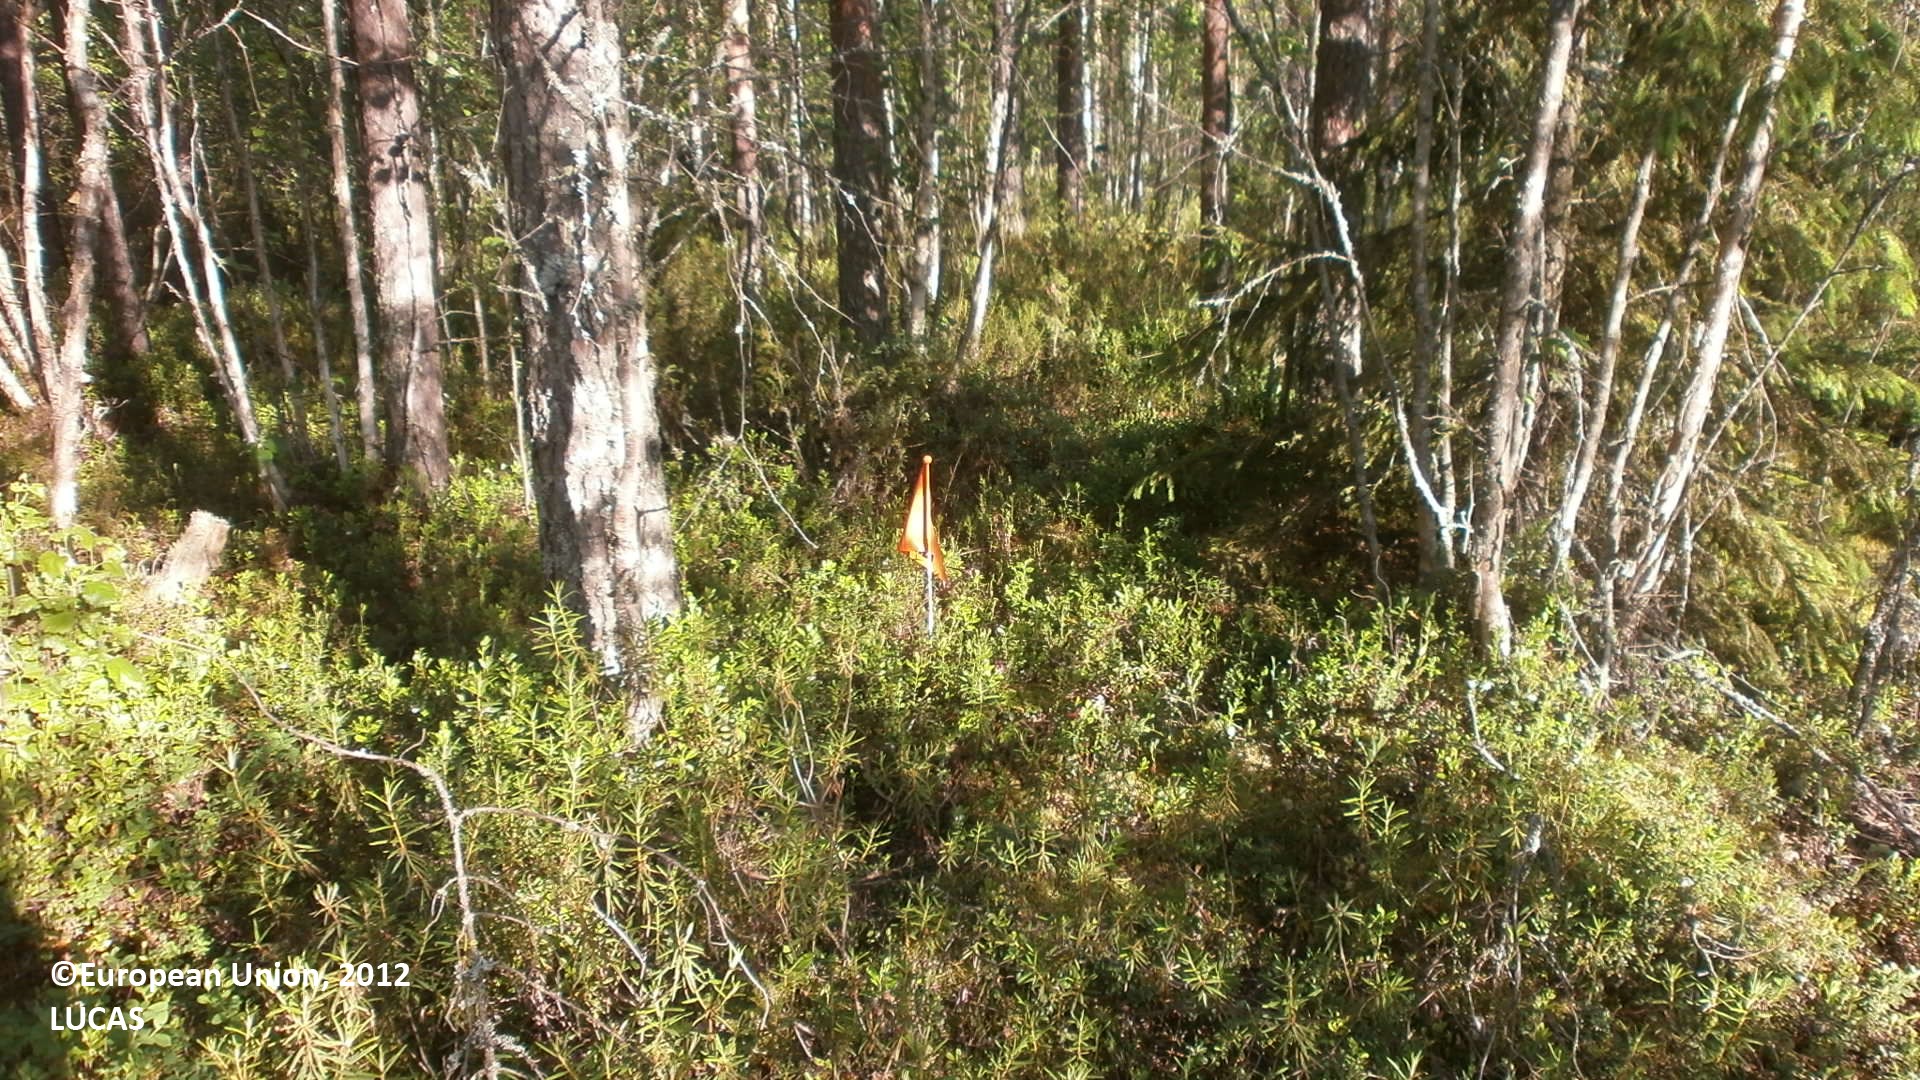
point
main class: Woodland
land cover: Pine dominated mixed woodland
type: boreal forest
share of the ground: > 75 %
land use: Forestry
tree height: > 5 m
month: July
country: FI
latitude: 64.0372
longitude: 24.9258
